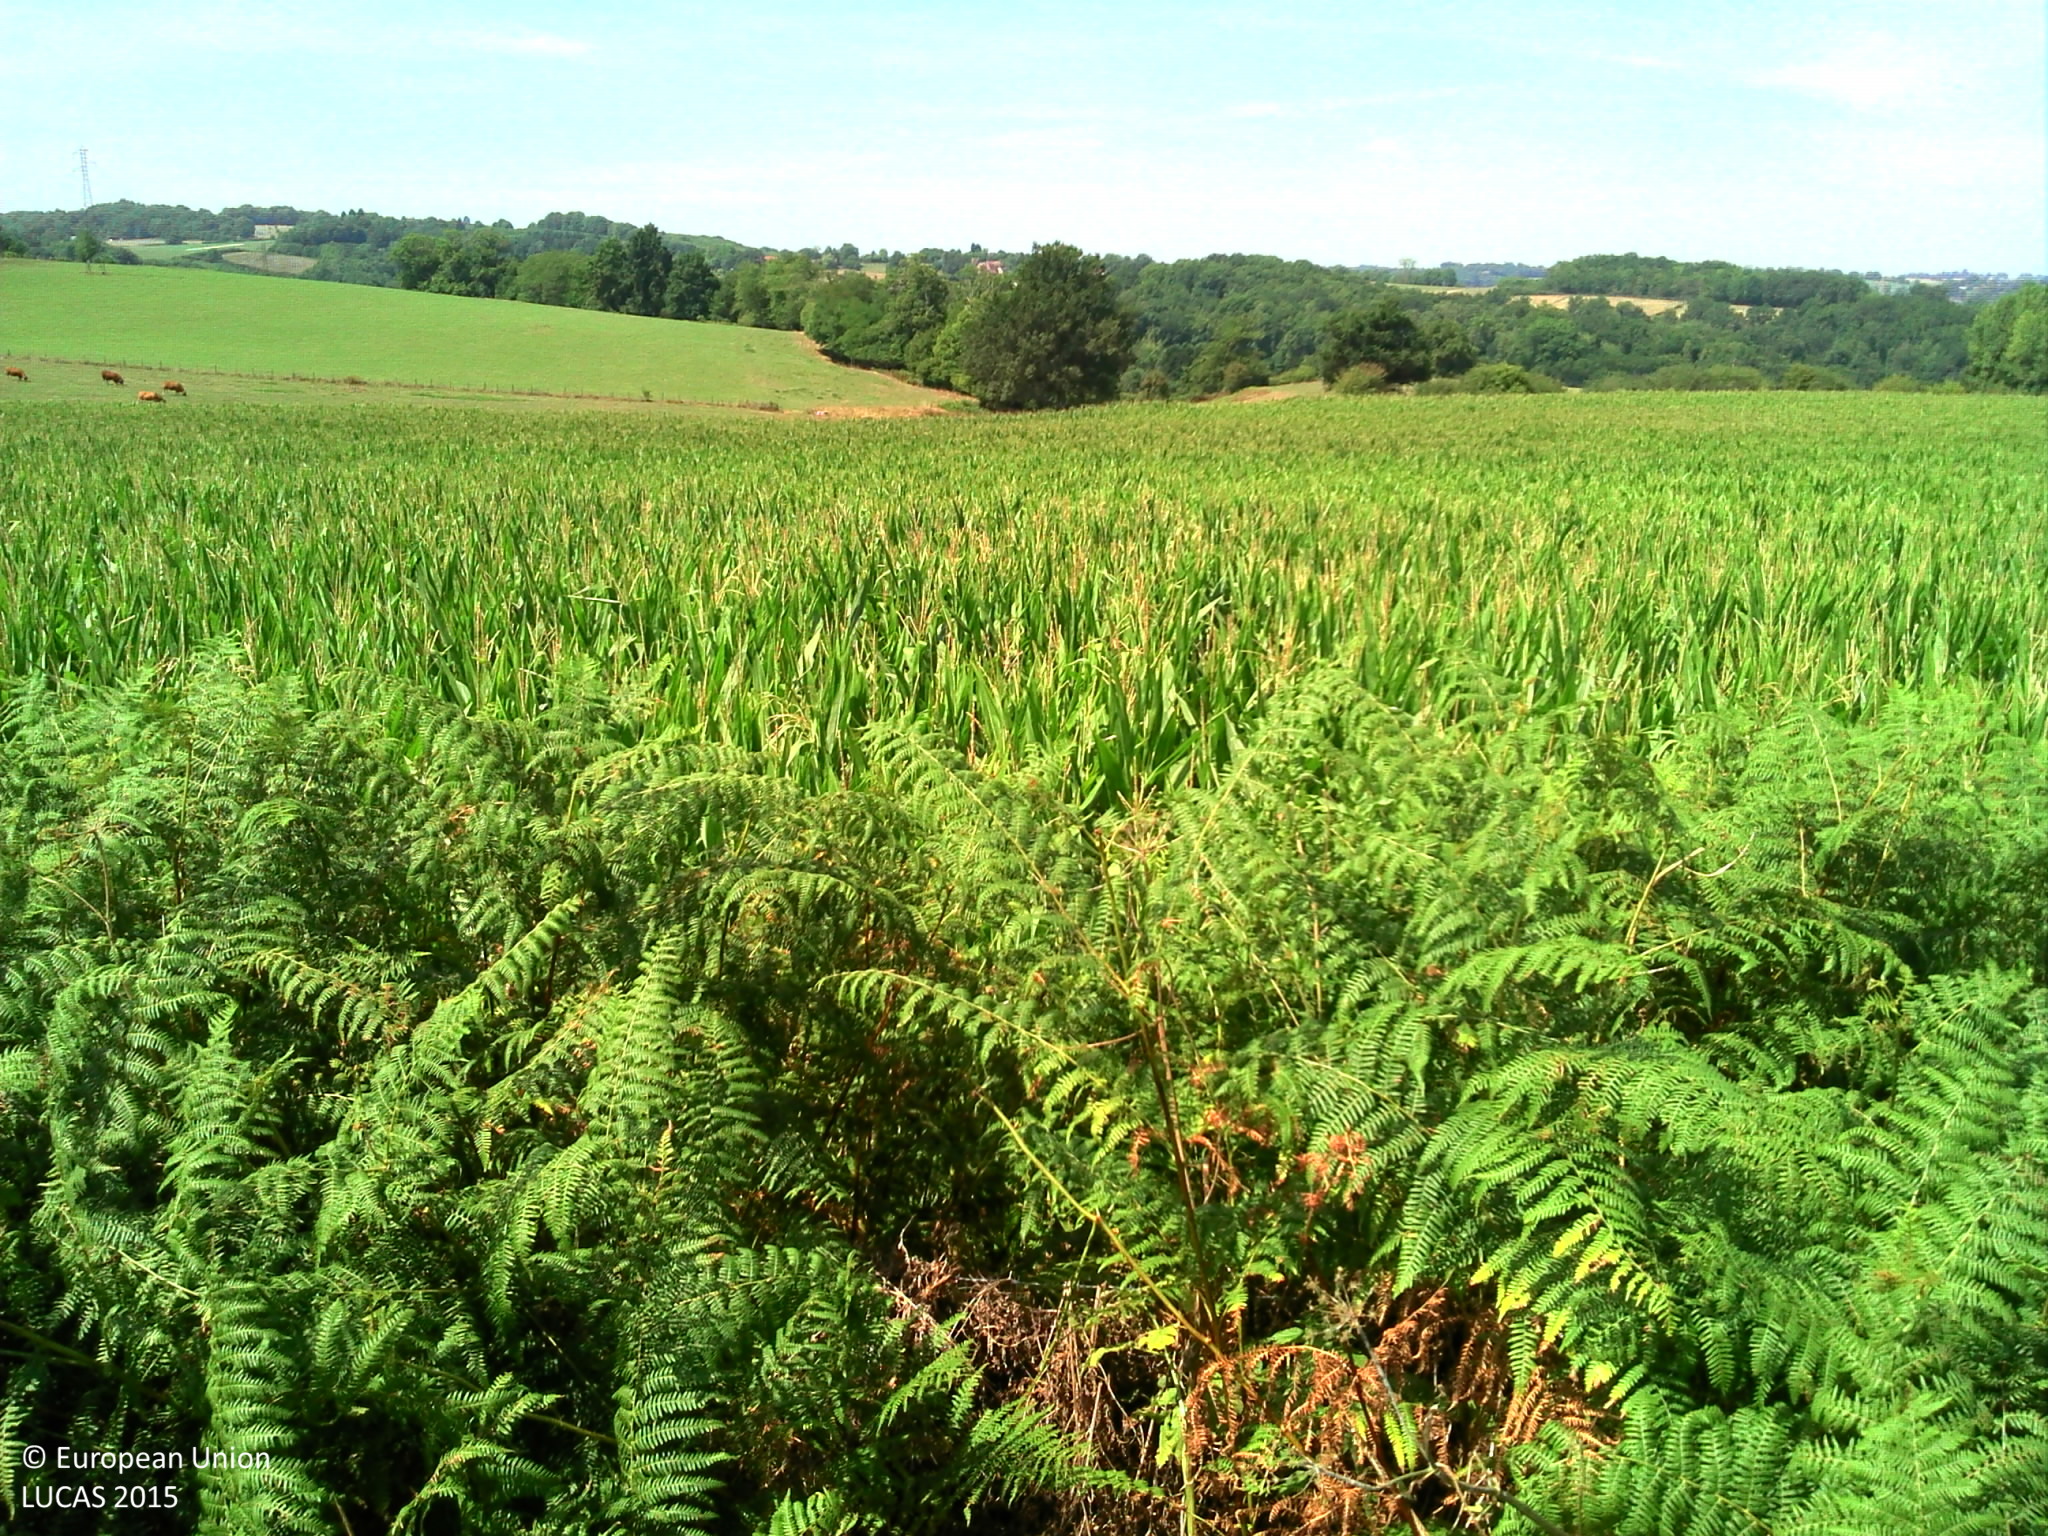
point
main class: Cropland
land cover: Maize
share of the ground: > 75 %
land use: Agriculture (excluding fallow land and kitchen gardens)
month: August
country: FR
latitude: 45.6345
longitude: 1.3072
